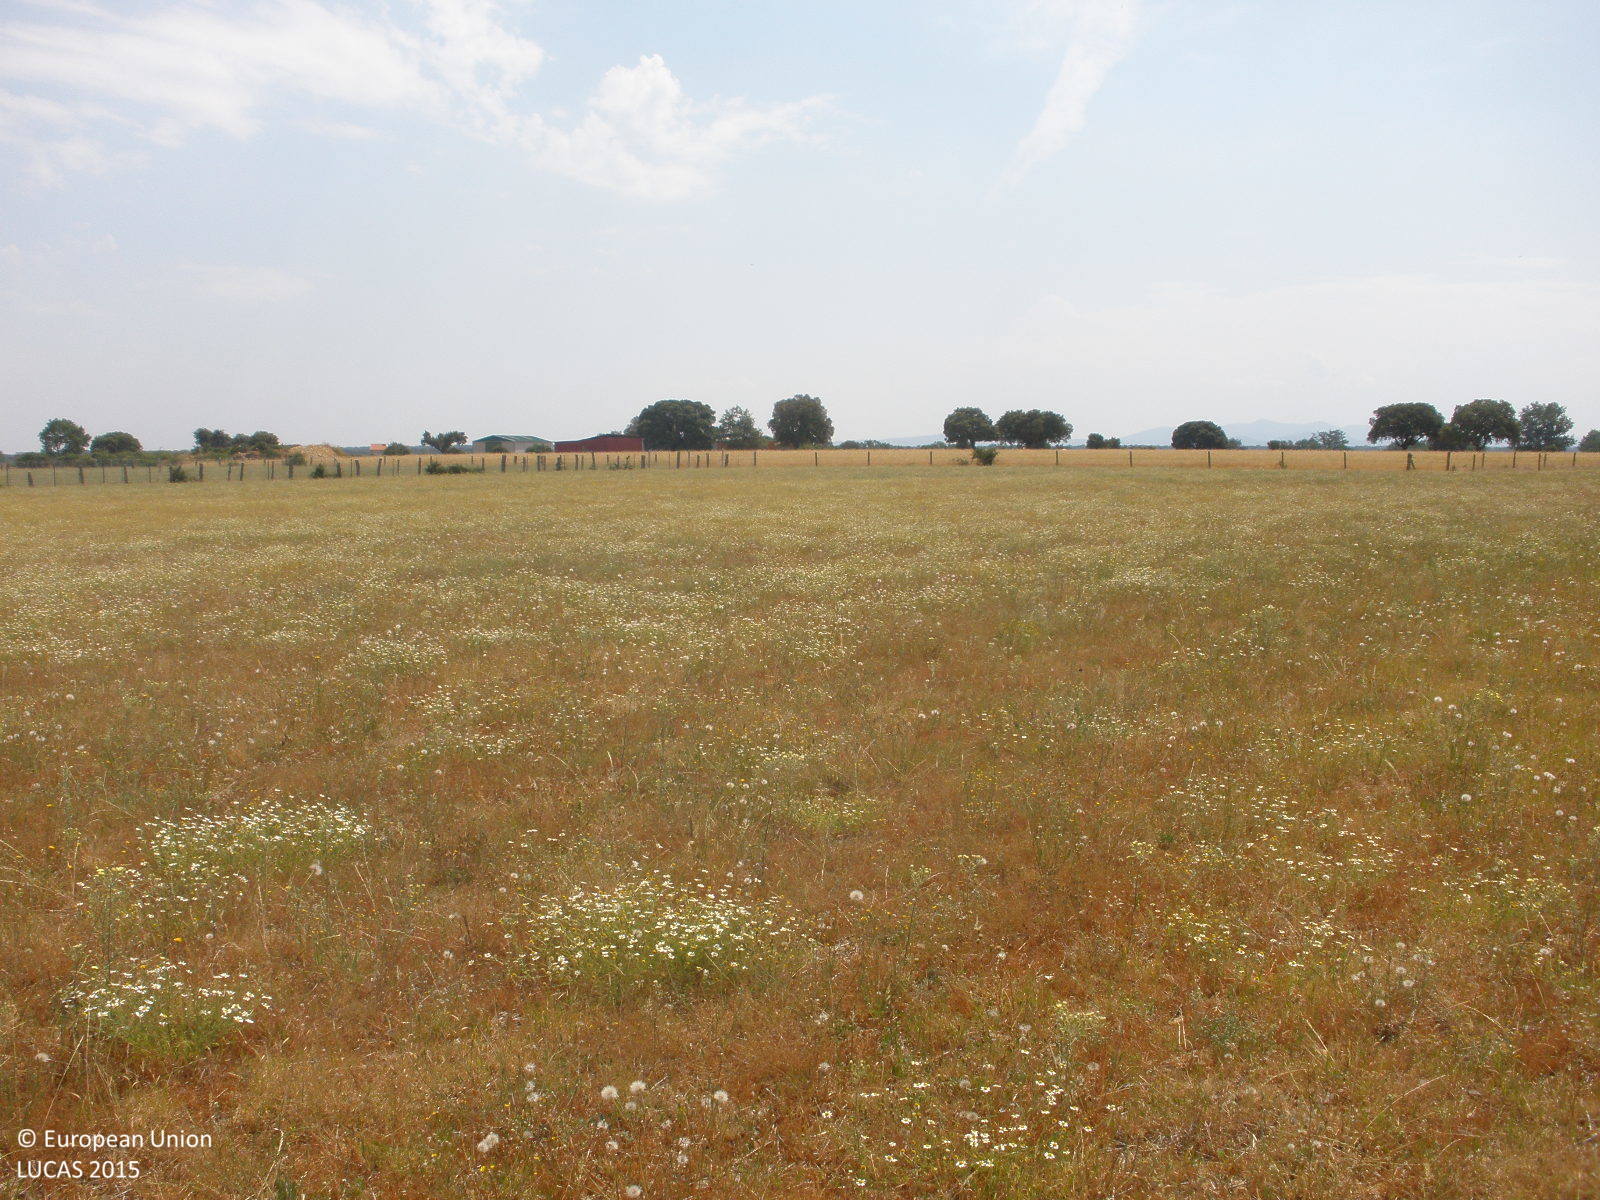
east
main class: Grassland
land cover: Grassland without tree/shrub cover
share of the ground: > 75 %
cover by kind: herbaceous plants 100 %
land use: Agriculture (excluding fallow land and kitchen gardens)
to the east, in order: Grassland without tree/shrub cover; Fences; Mixed cereals for fodder
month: June
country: ES
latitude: 40.6392
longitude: -6.3205
